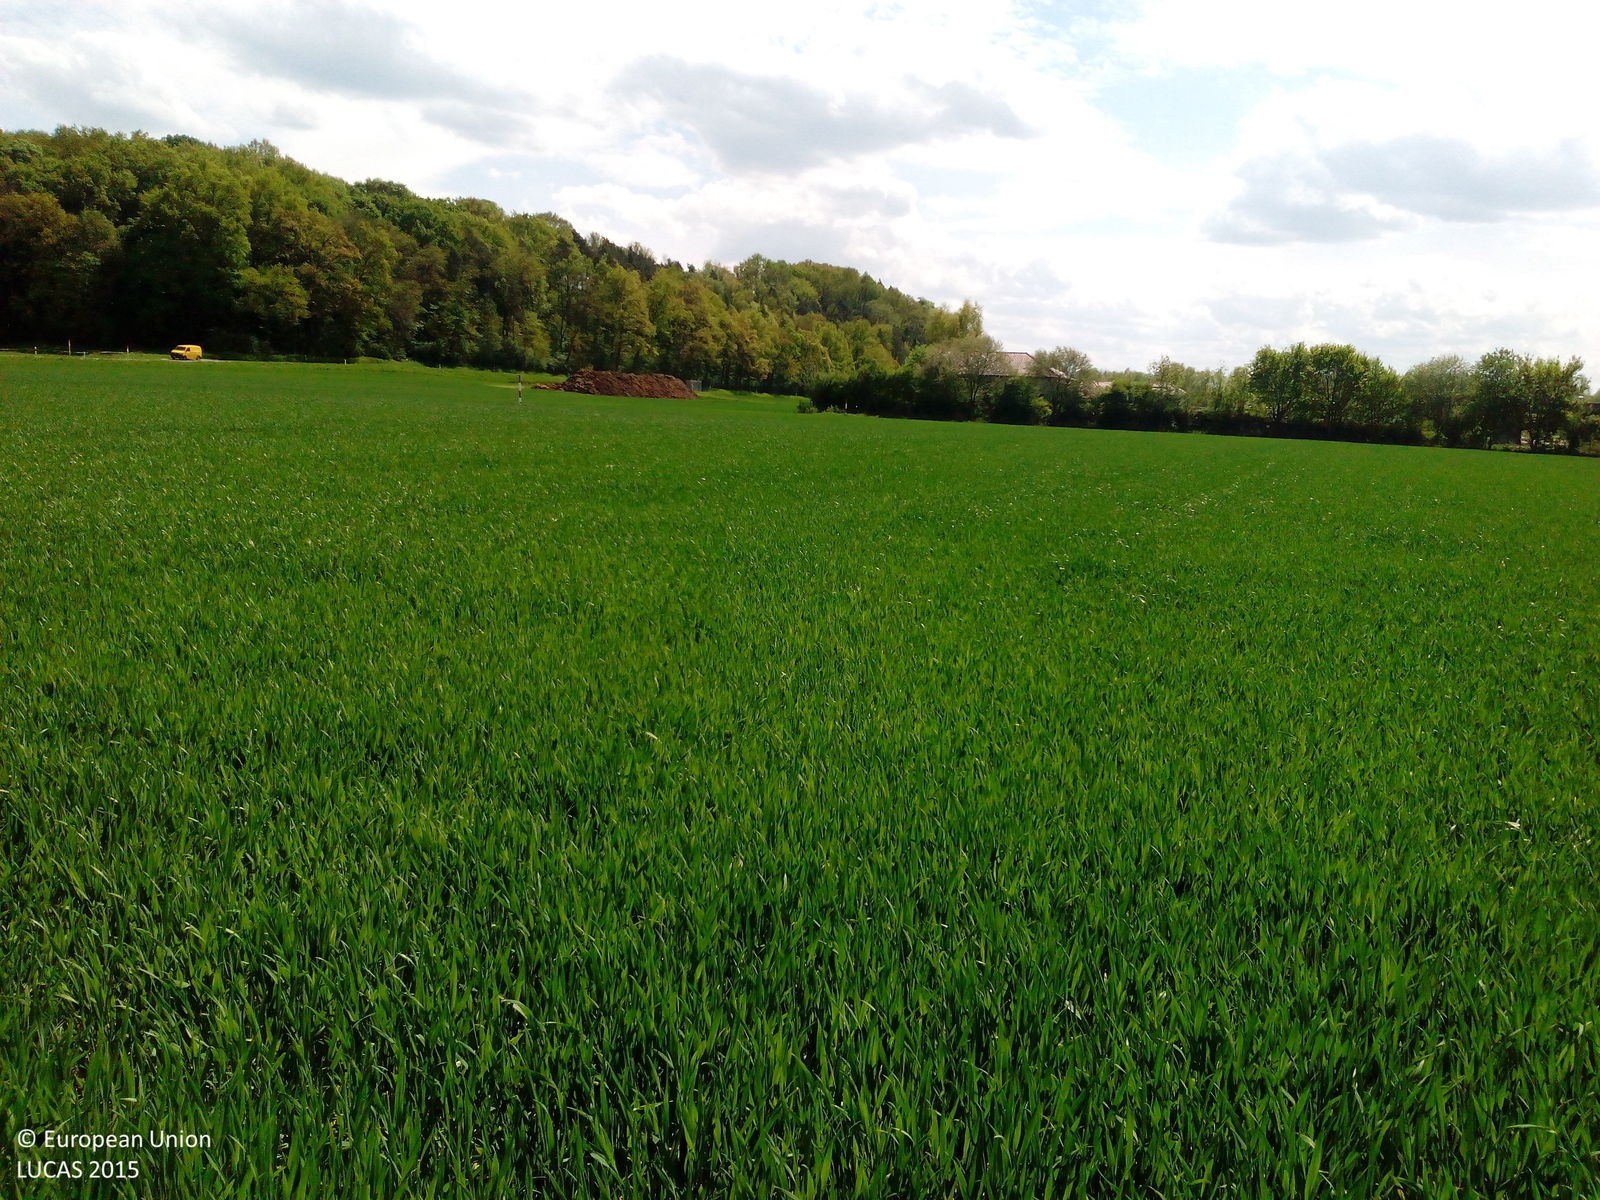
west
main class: Cropland
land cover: Common wheat
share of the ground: > 75 %
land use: Agriculture (excluding fallow land and kitchen gardens)
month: May
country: DE
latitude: 50.8743
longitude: 11.6055
